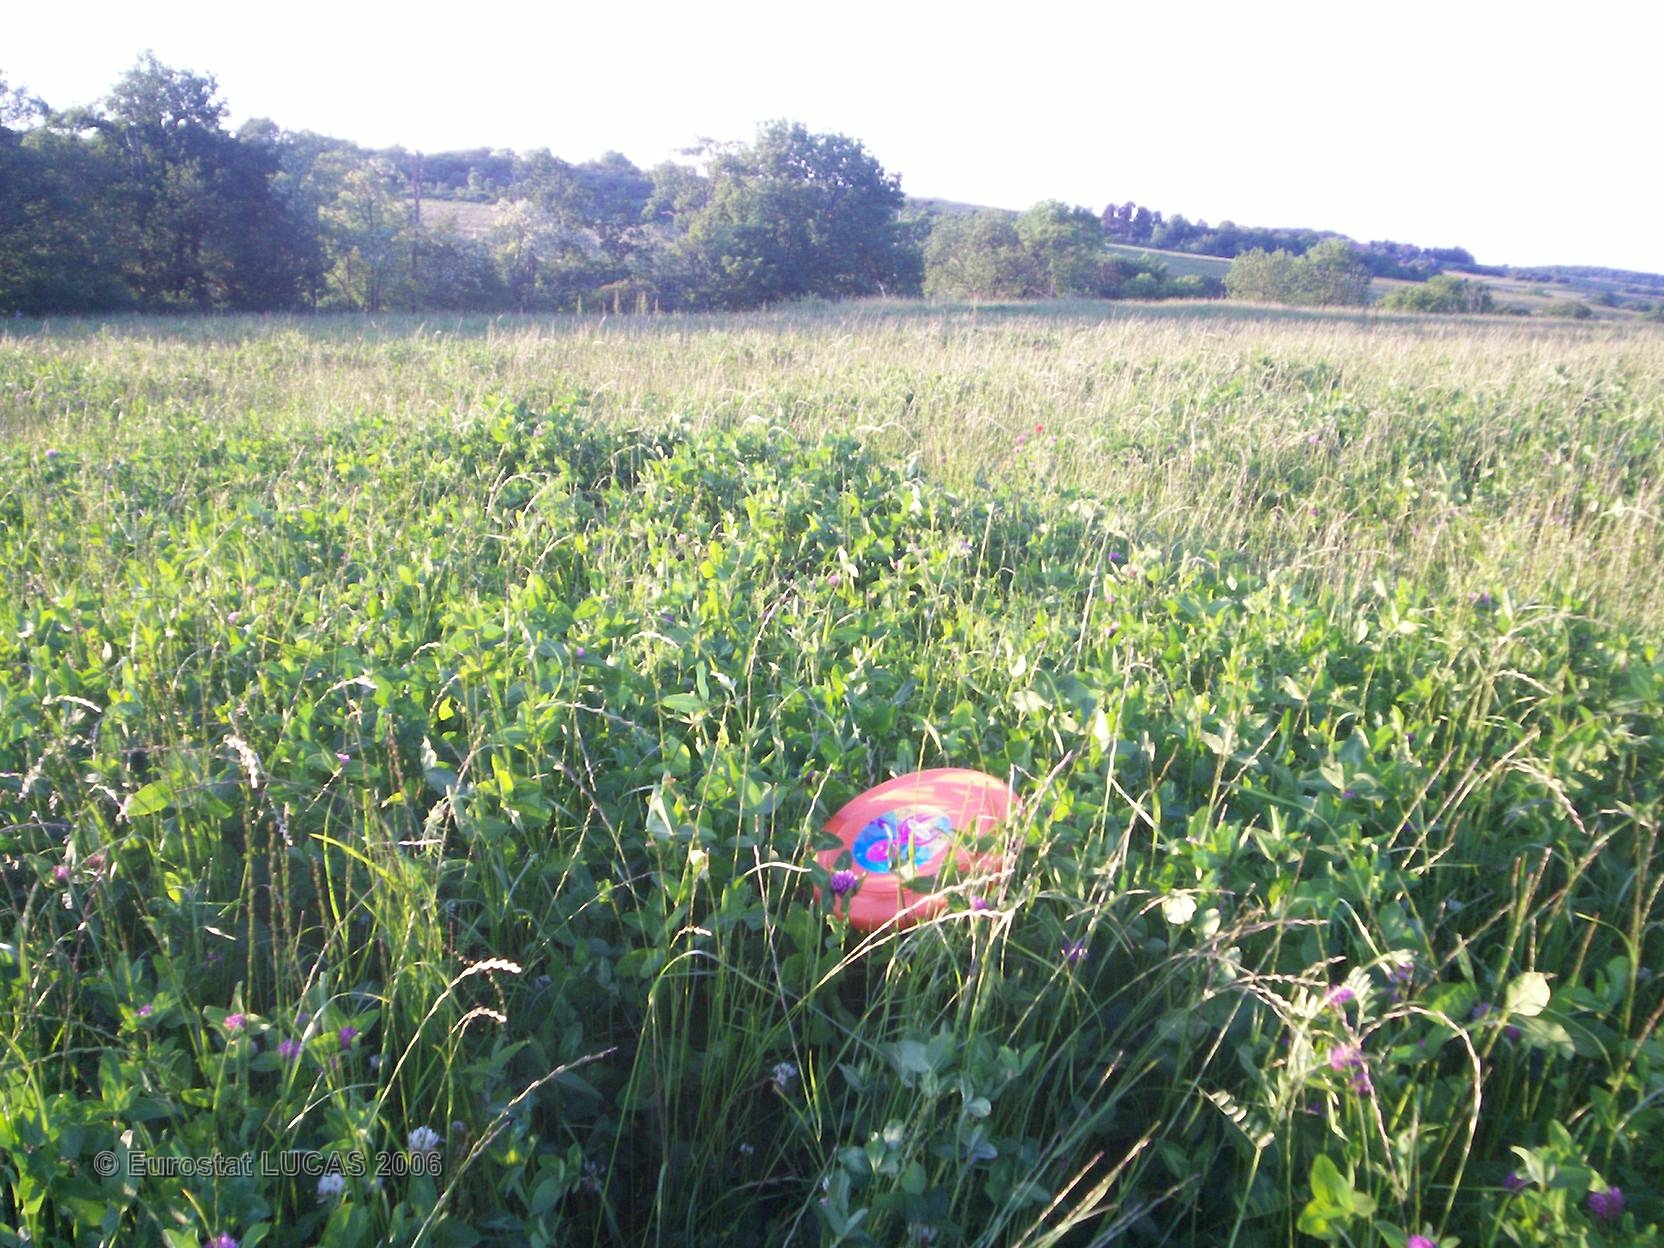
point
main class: Cropland
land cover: Other leguminous and mixtures for fodder
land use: Agriculture (excluding fallow land and kitchen gardens)
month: June
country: FR
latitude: 46.0762
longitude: 3.1330
